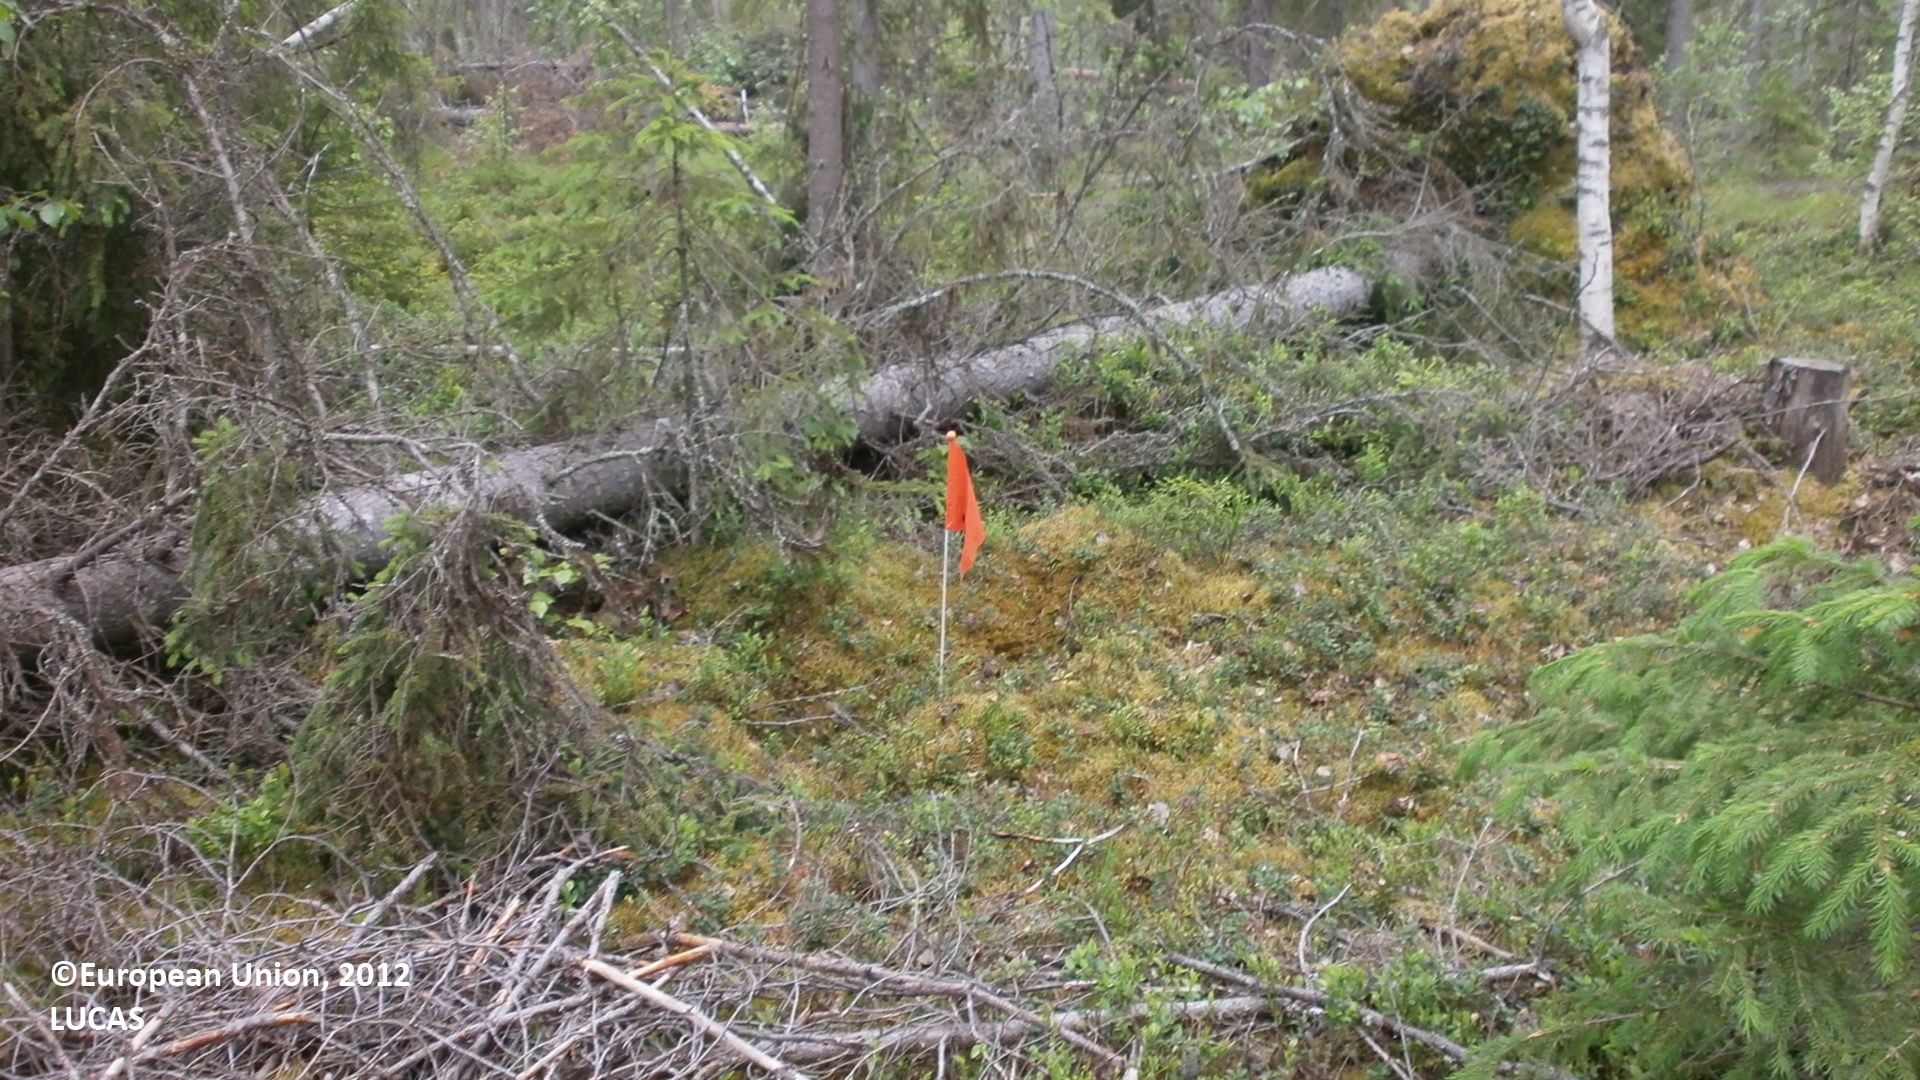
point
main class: Woodland
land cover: Other coniferous woodland
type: boreal forest
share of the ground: 50 - 75 %
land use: Forestry
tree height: > 5 m
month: June
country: FI
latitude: 64.2119
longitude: 25.7779
